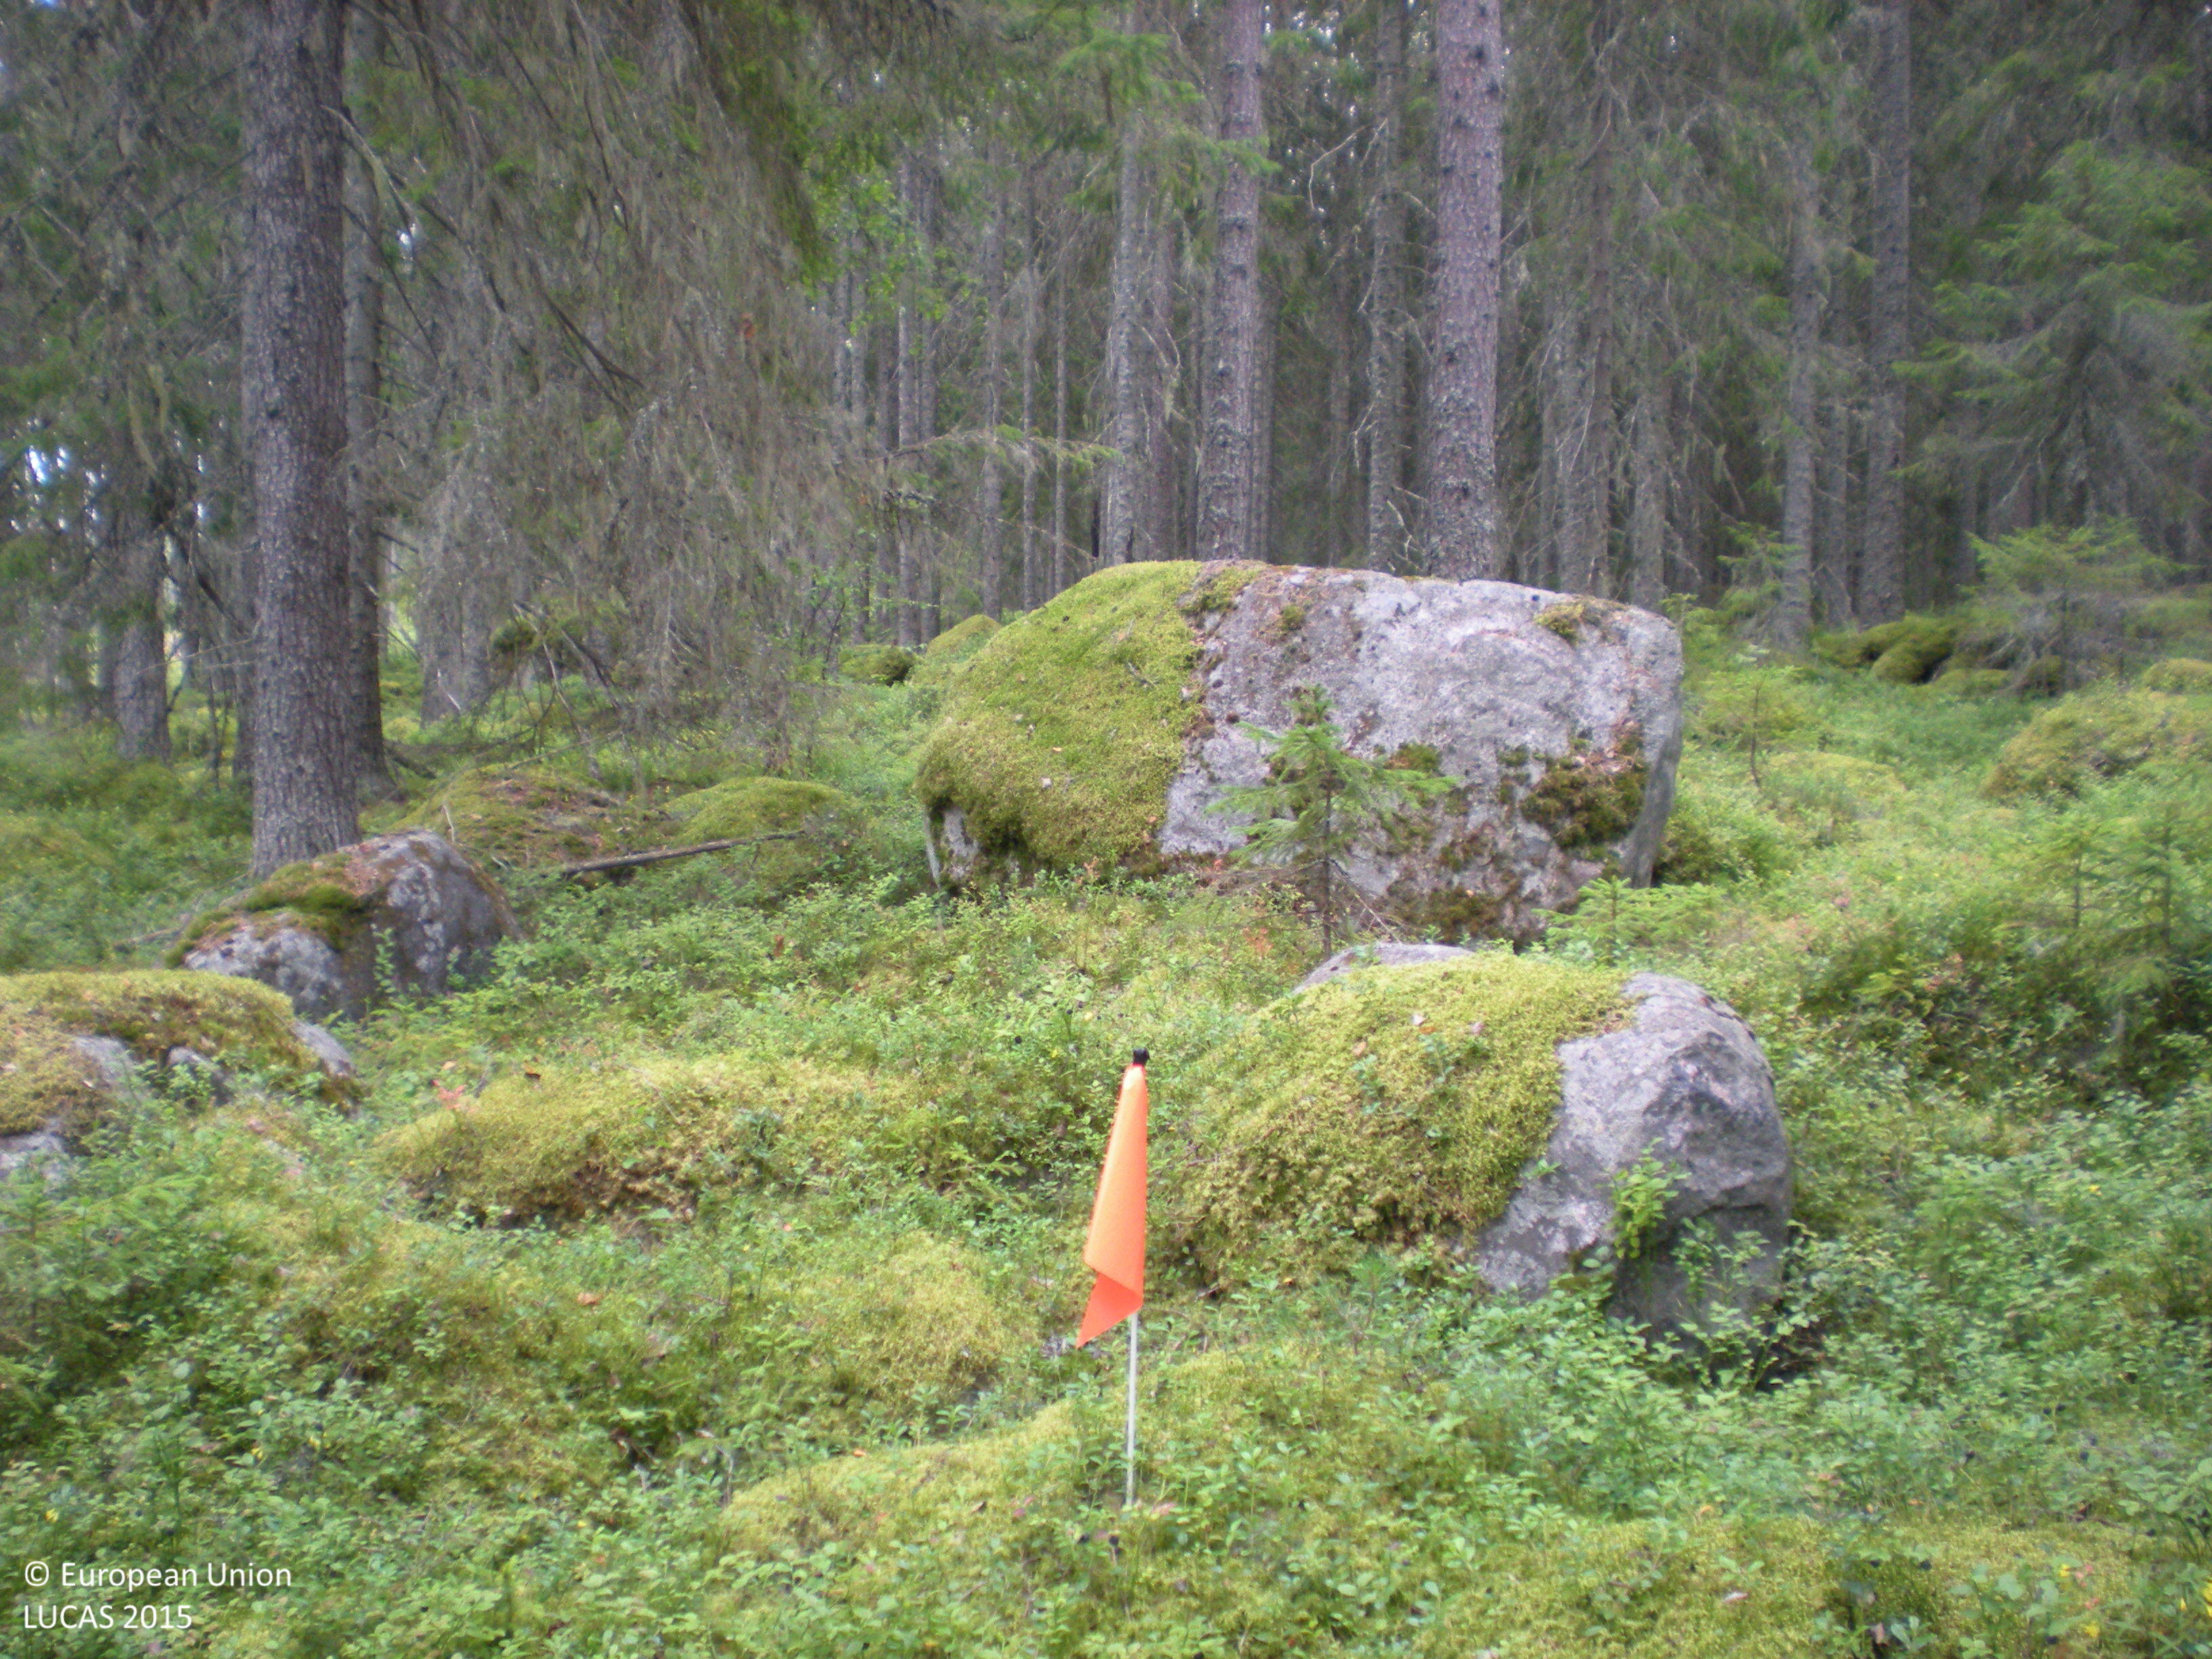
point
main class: Woodland
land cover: Other coniferous woodland
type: boreal forest
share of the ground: 50 - 75 %
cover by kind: coniferous forest trees 65 %, shrubs 15 %, lichens and mosses 10 %, herbaceous plants 5 %, consolidated bare surface 5 %
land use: Forestry
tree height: > 5 m
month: August
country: SE
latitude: 60.8477
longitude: 17.1838
